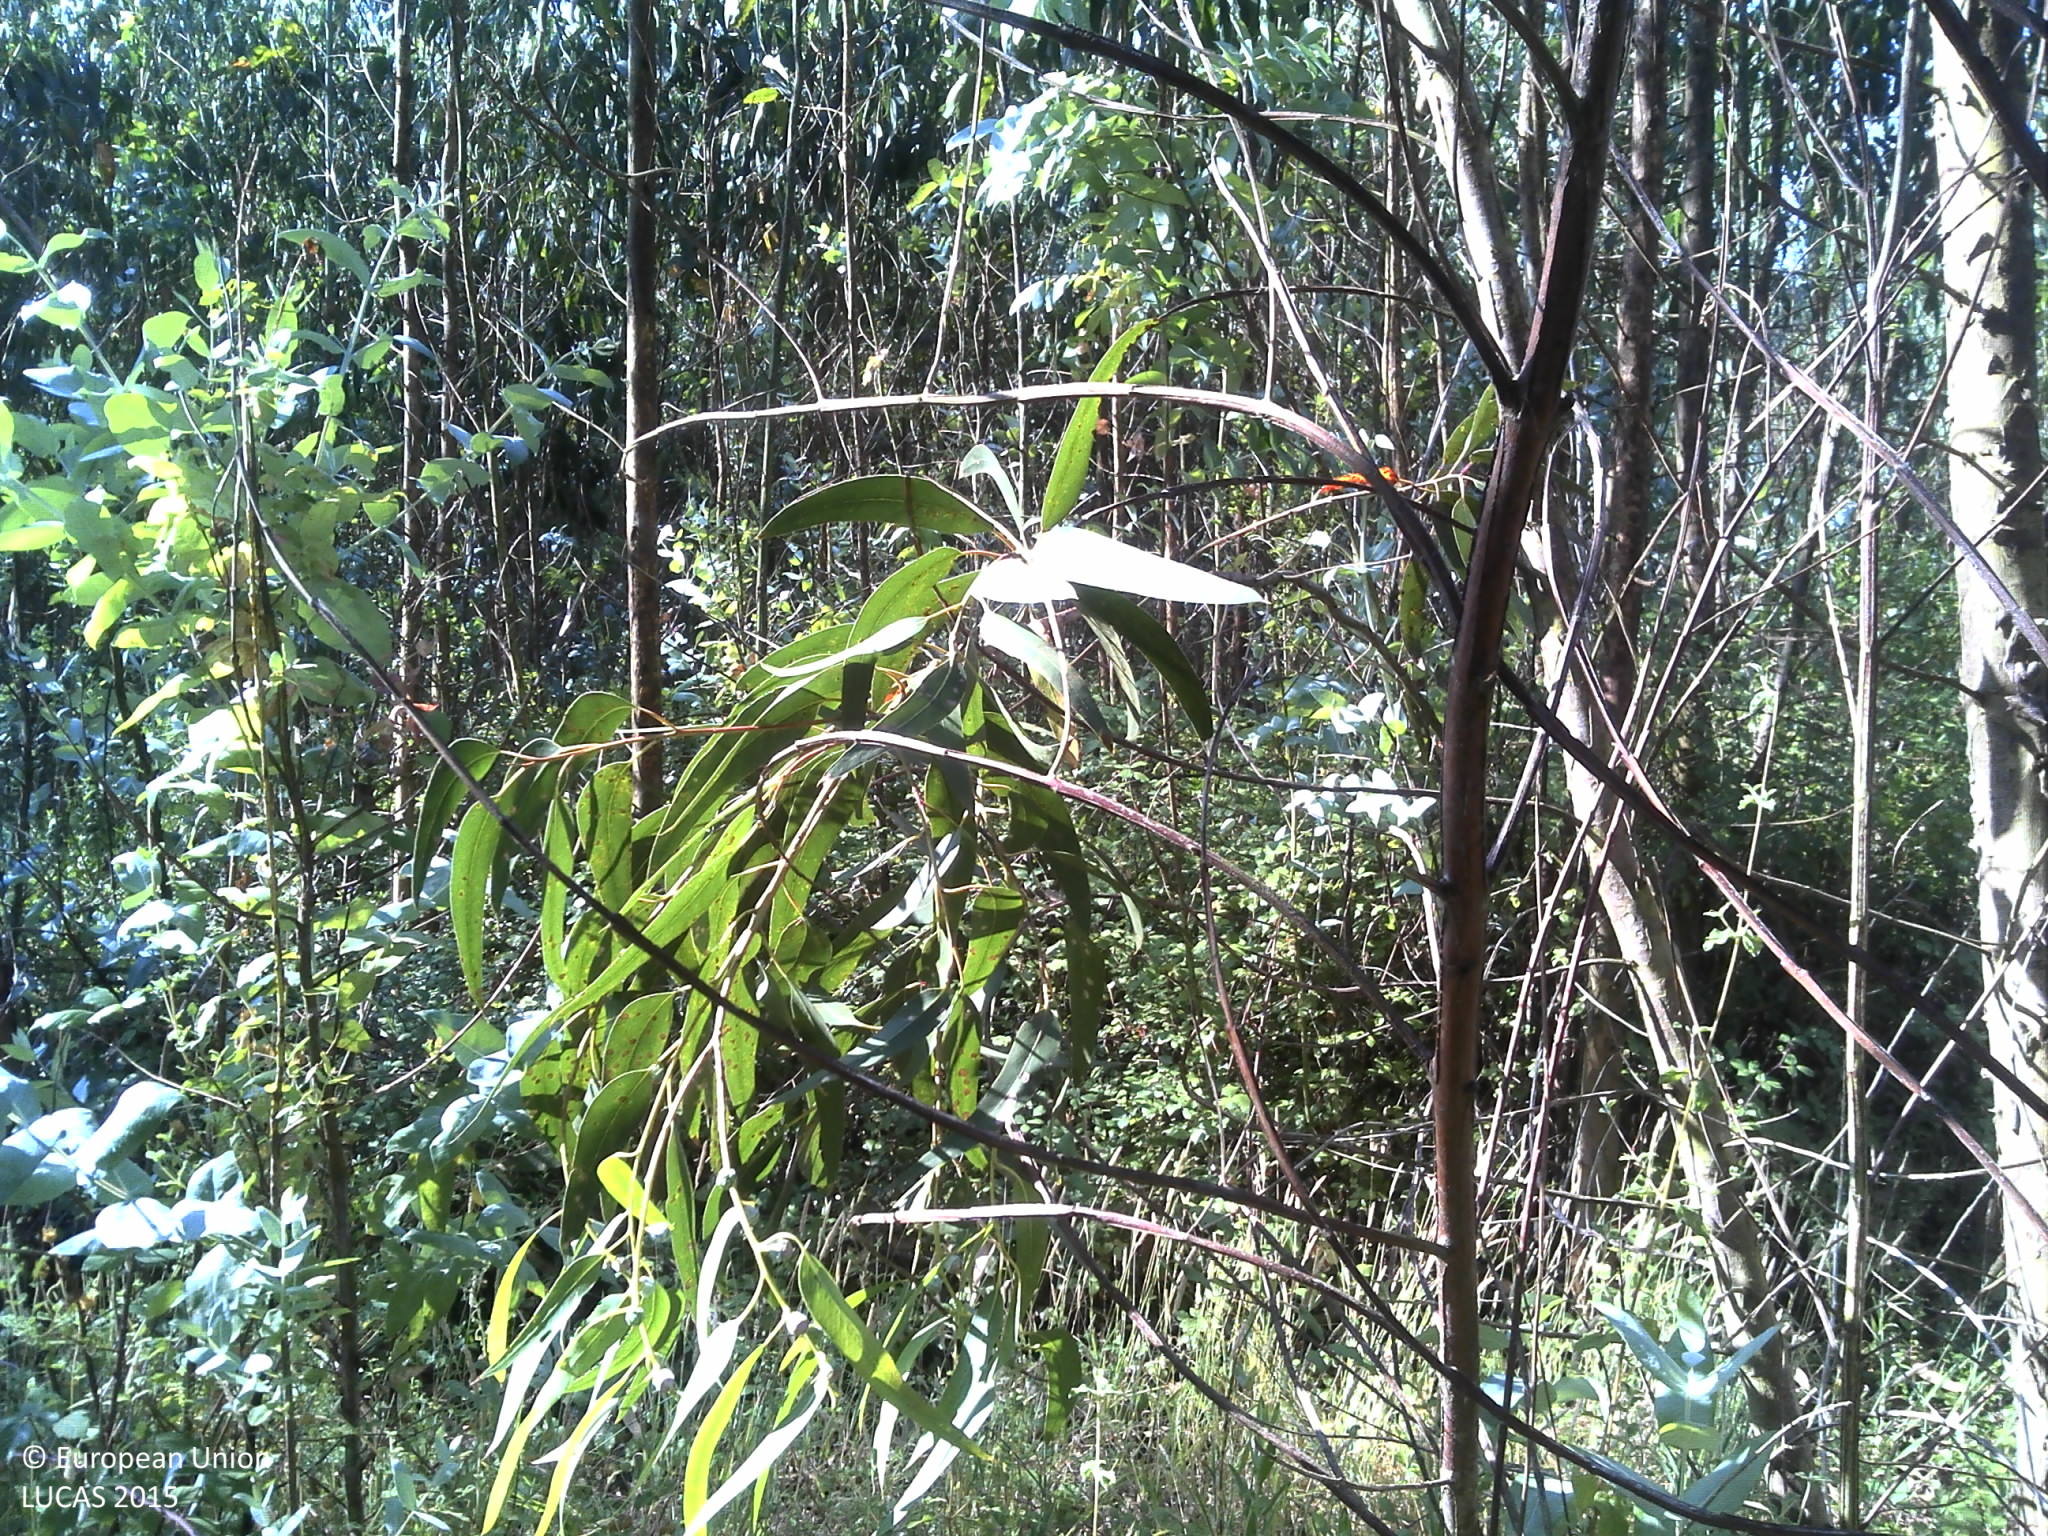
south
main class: Woodland
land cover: Broadleaved woodland
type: exotic forest
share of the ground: > 75 %
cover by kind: broadleaved forest trees 70 %, shrubs 20 %, herbaceous plants 5 %, unconsolidated bare surface 5 %
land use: Forestry
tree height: > 5 m
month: July
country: PT
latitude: 39.9140
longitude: -8.5057
